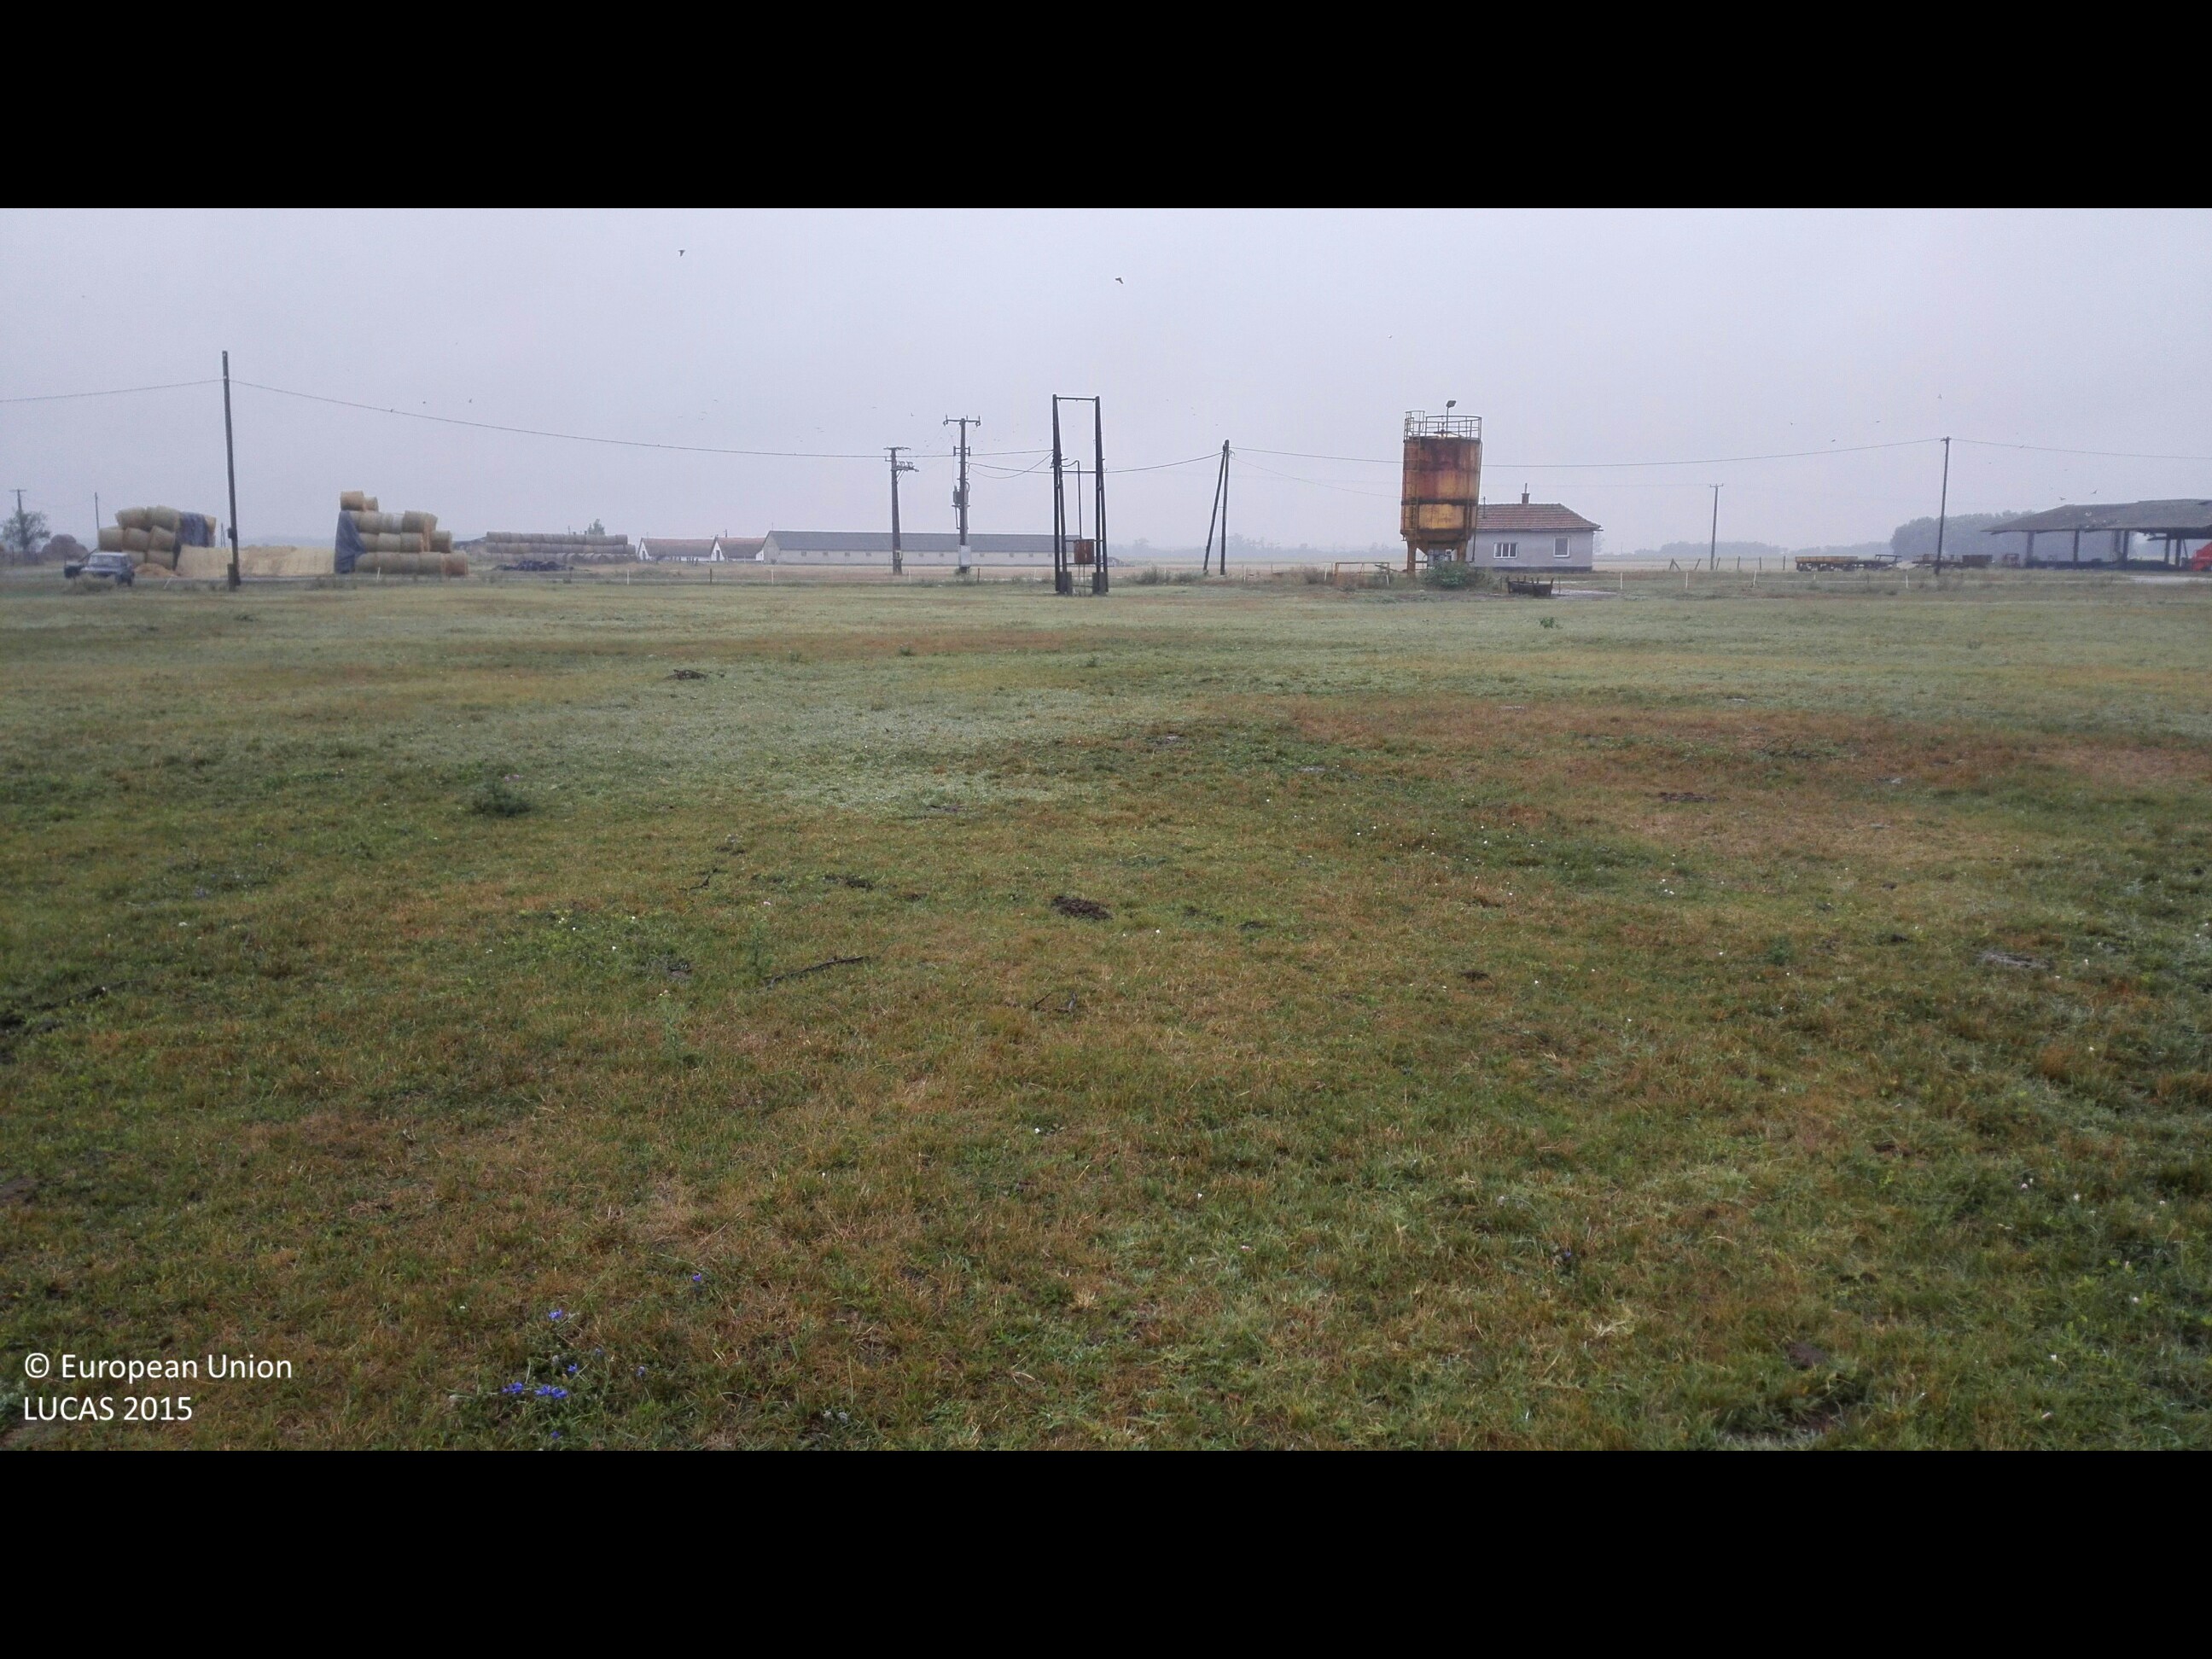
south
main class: Grassland
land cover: Grassland without tree/shrub cover
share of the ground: > 75 %
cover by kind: herbaceous plants 100 %
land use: Agriculture (excluding fallow land and kitchen gardens)
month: August
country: HU
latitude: 47.1861
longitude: 21.6432
